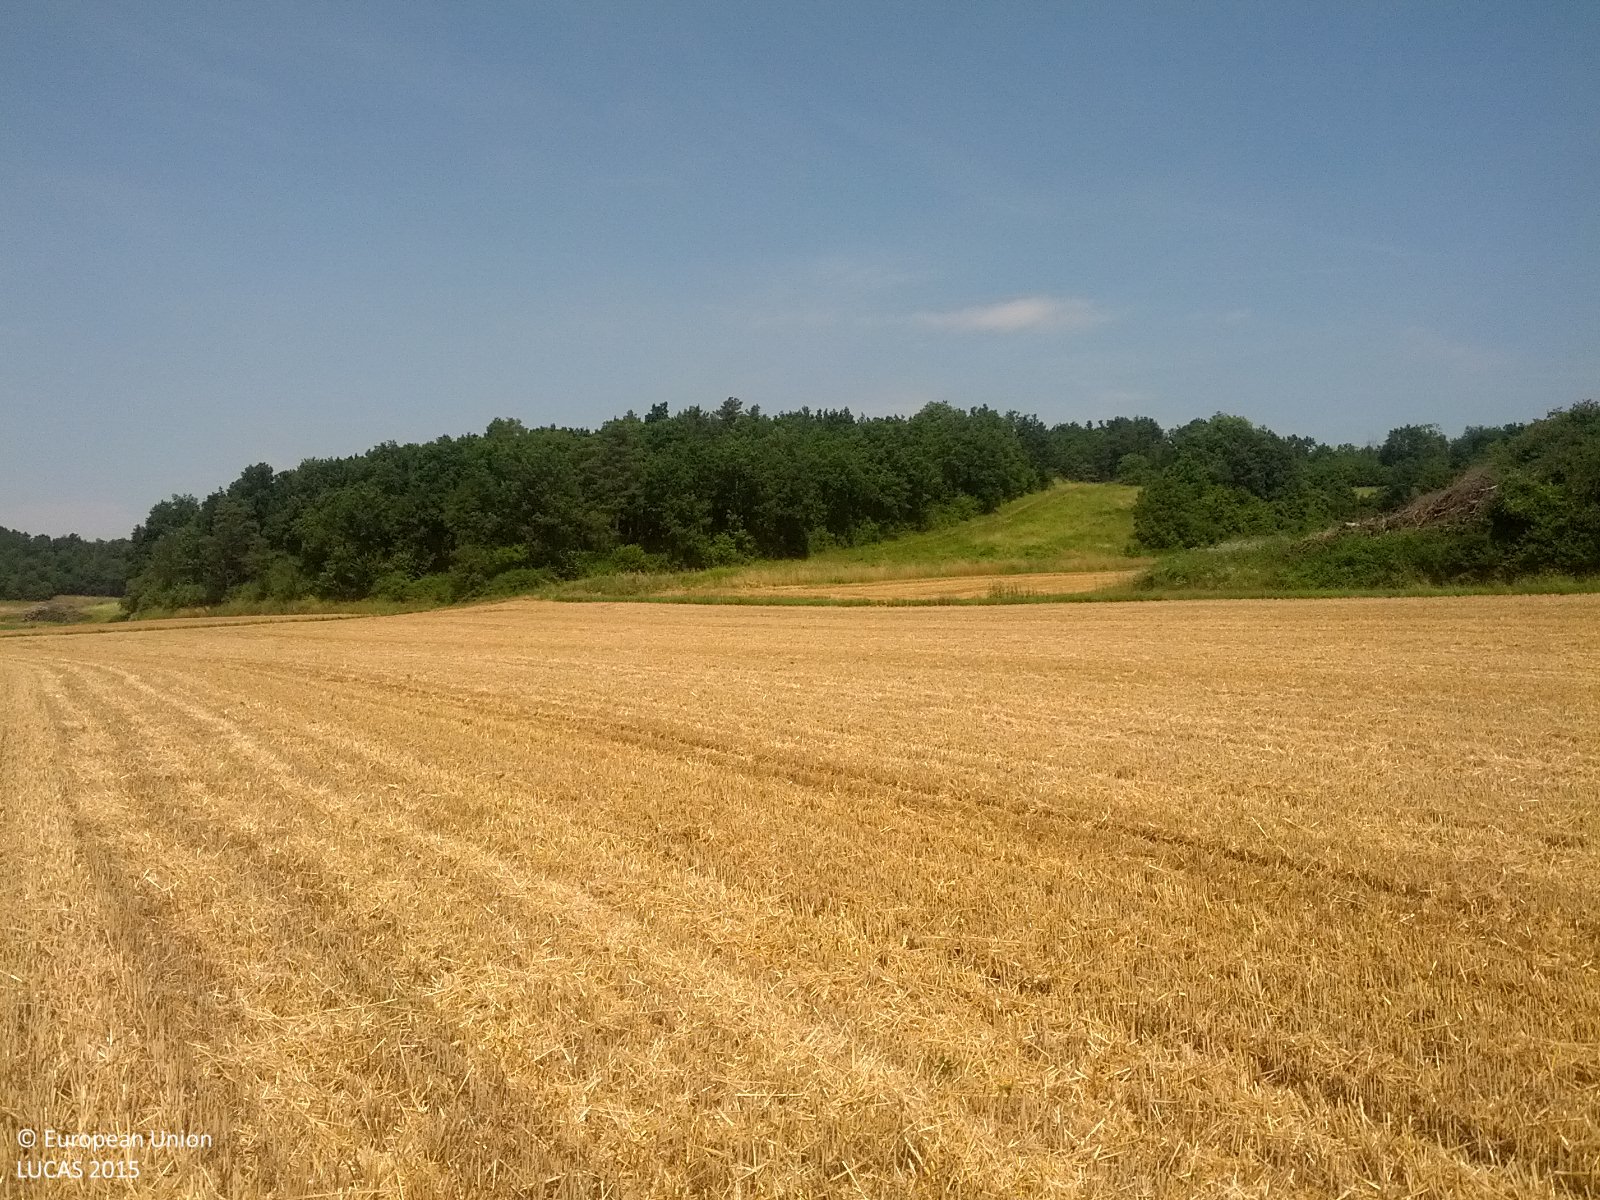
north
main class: Cropland
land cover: Durum wheat
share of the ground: > 75 %
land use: Agriculture (excluding fallow land and kitchen gardens)
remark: Harvested field
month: July
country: AT
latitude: 48.5335
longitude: 16.2483
